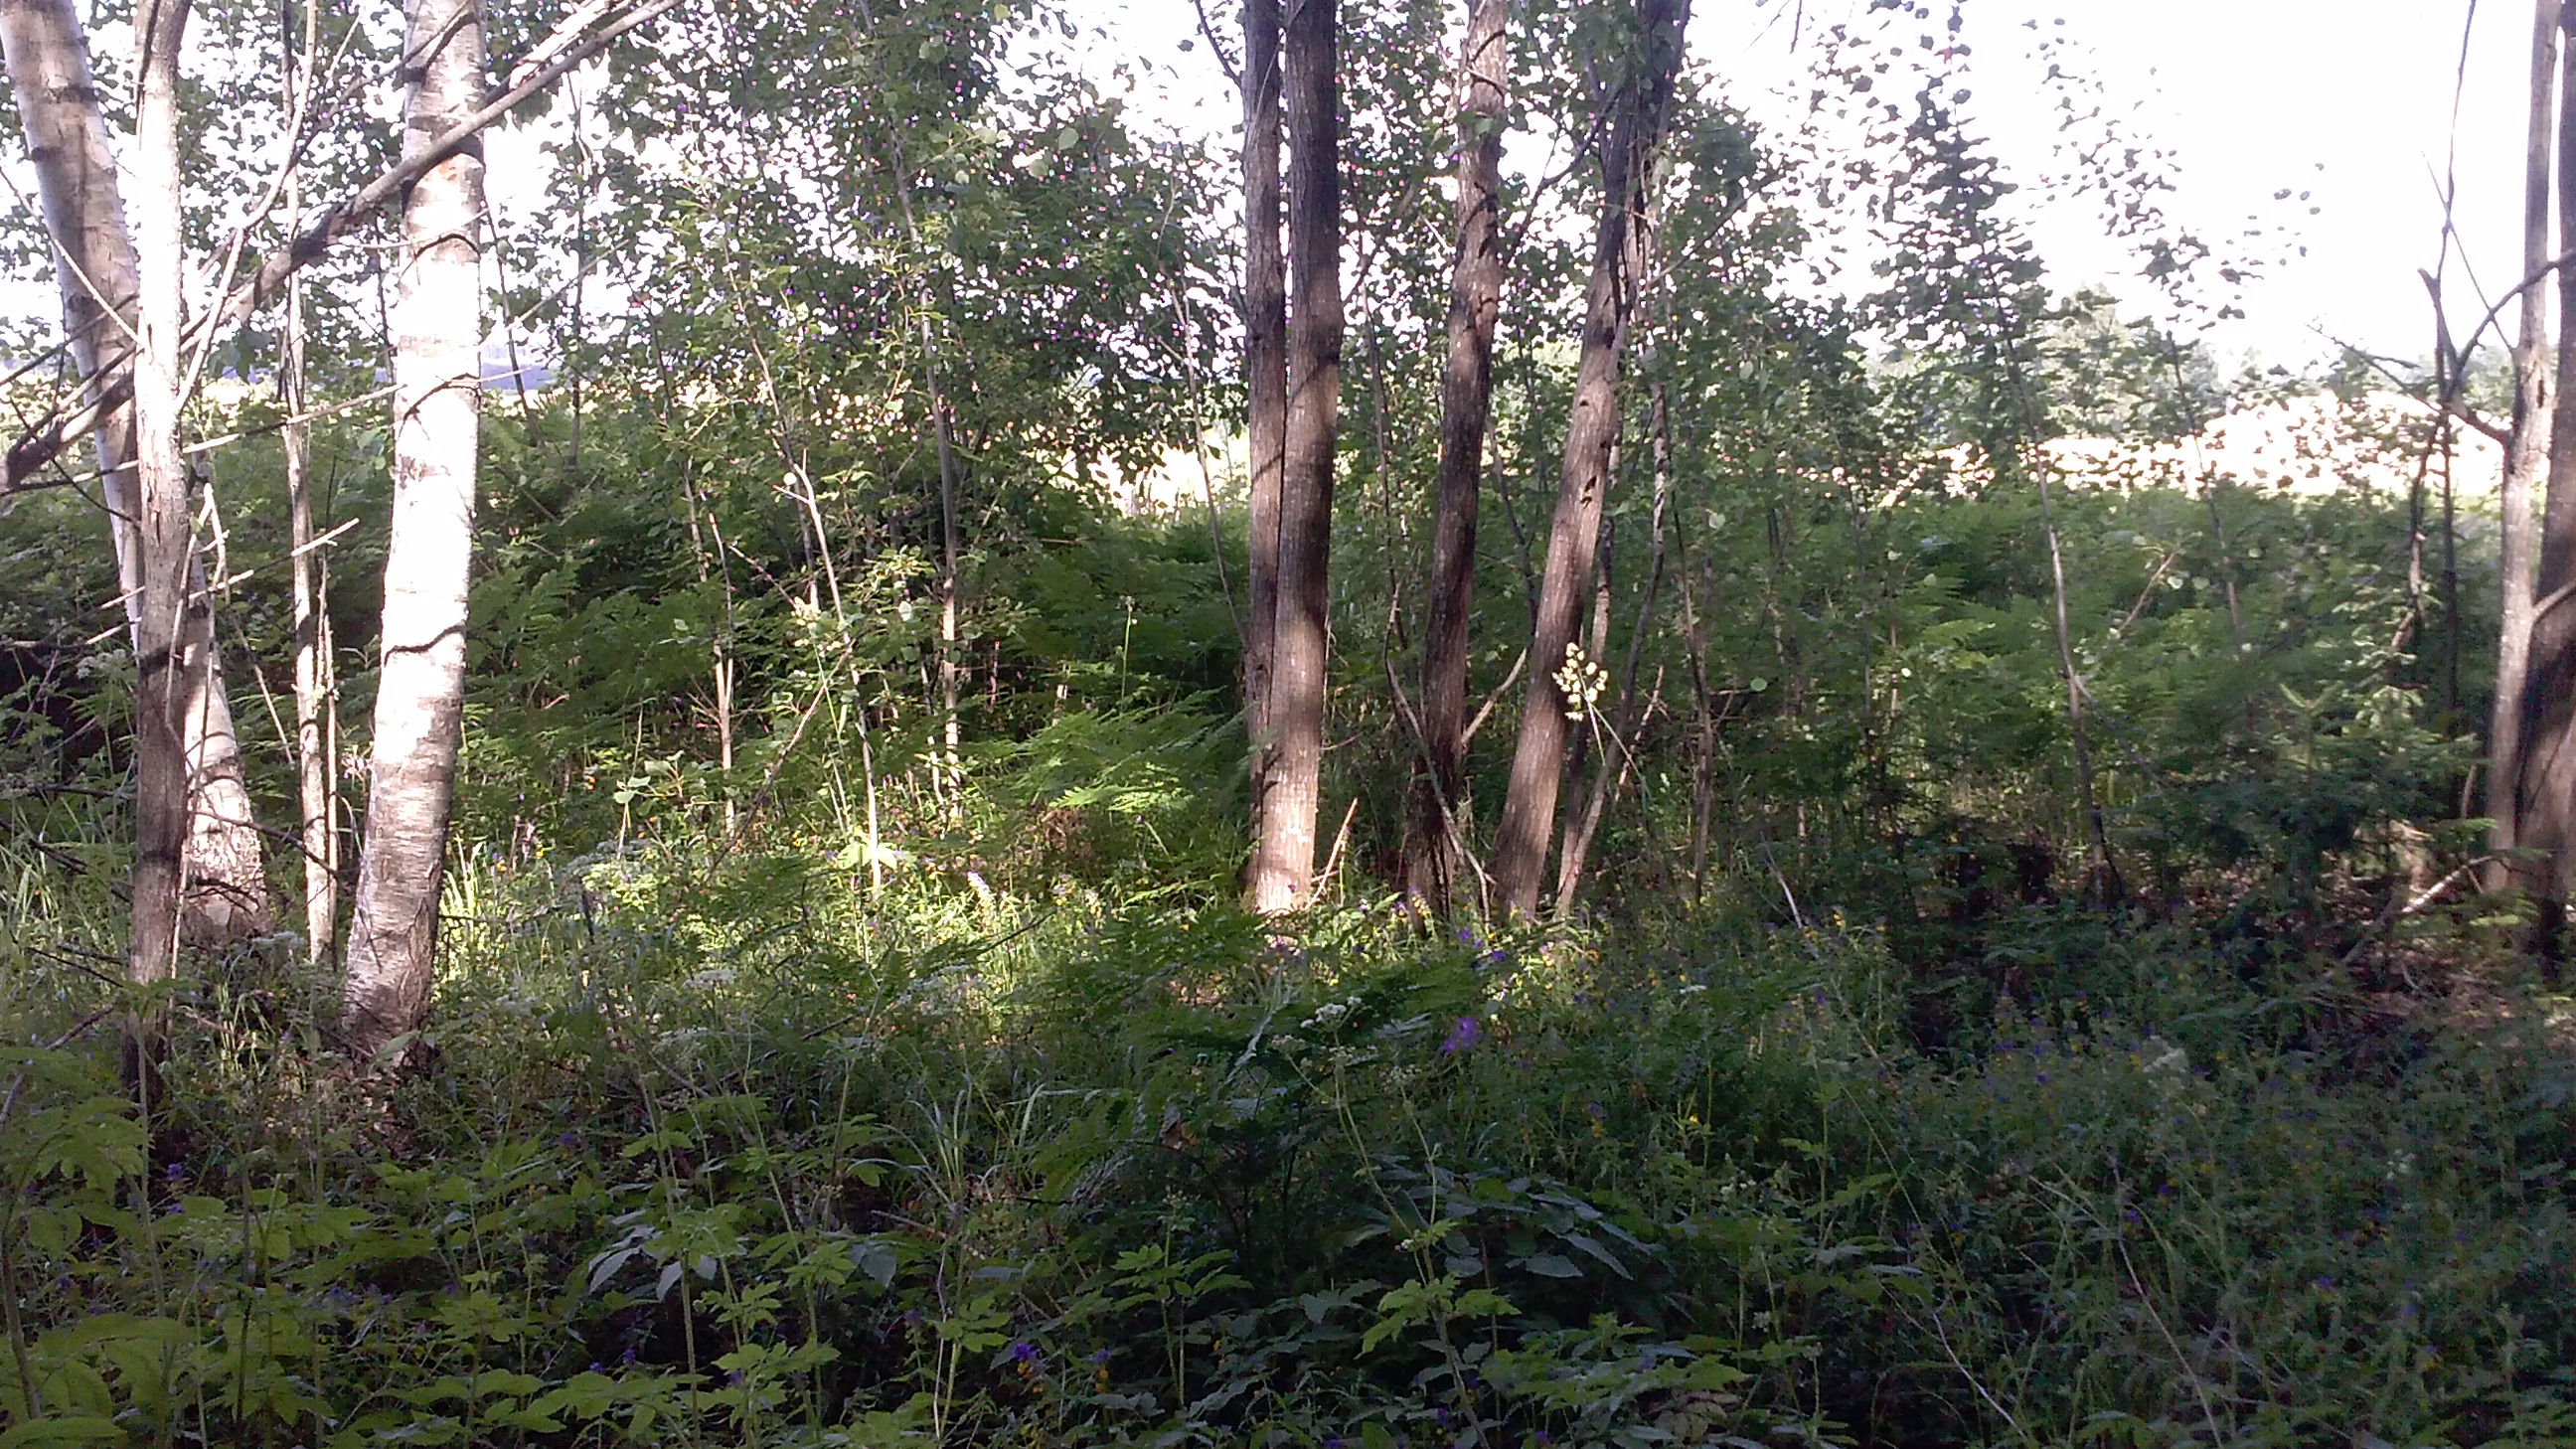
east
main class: Woodland
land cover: Broadleaved woodland
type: non-riverine alder, birch or aspen forest
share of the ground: > 75 %
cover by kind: broadleaved forest trees 80 %, herbaceous plants 10 %, coniferous forest trees 5 %, shrubs 5 %
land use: Forestry
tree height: > 5 m
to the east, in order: Broadleaved woodland; Sand; Spontaneously vegetated surfaces
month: June
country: LV
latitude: 56.5172
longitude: 27.9254
